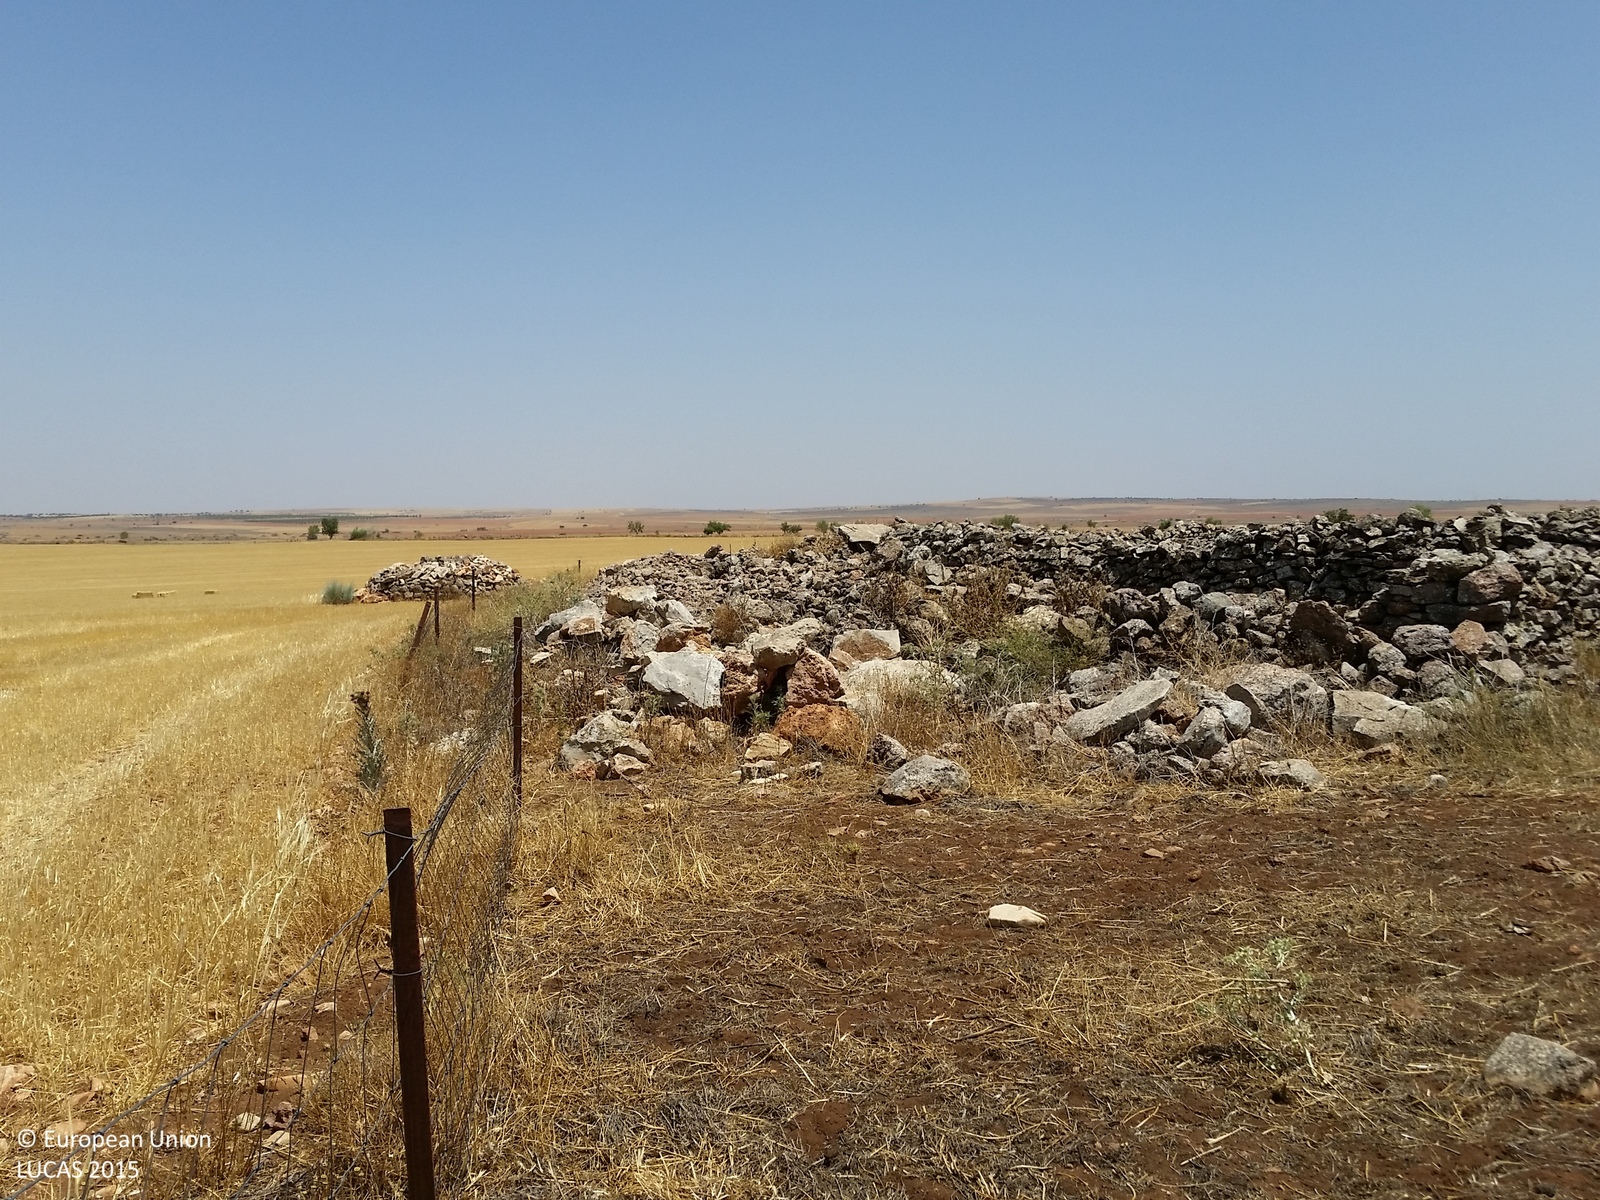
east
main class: Cropland
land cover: Barley
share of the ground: < 10 %
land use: Agriculture (excluding fallow land and kitchen gardens)
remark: Harvested field
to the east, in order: Barley
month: July
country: ES
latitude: 38.8687
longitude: -2.5788
